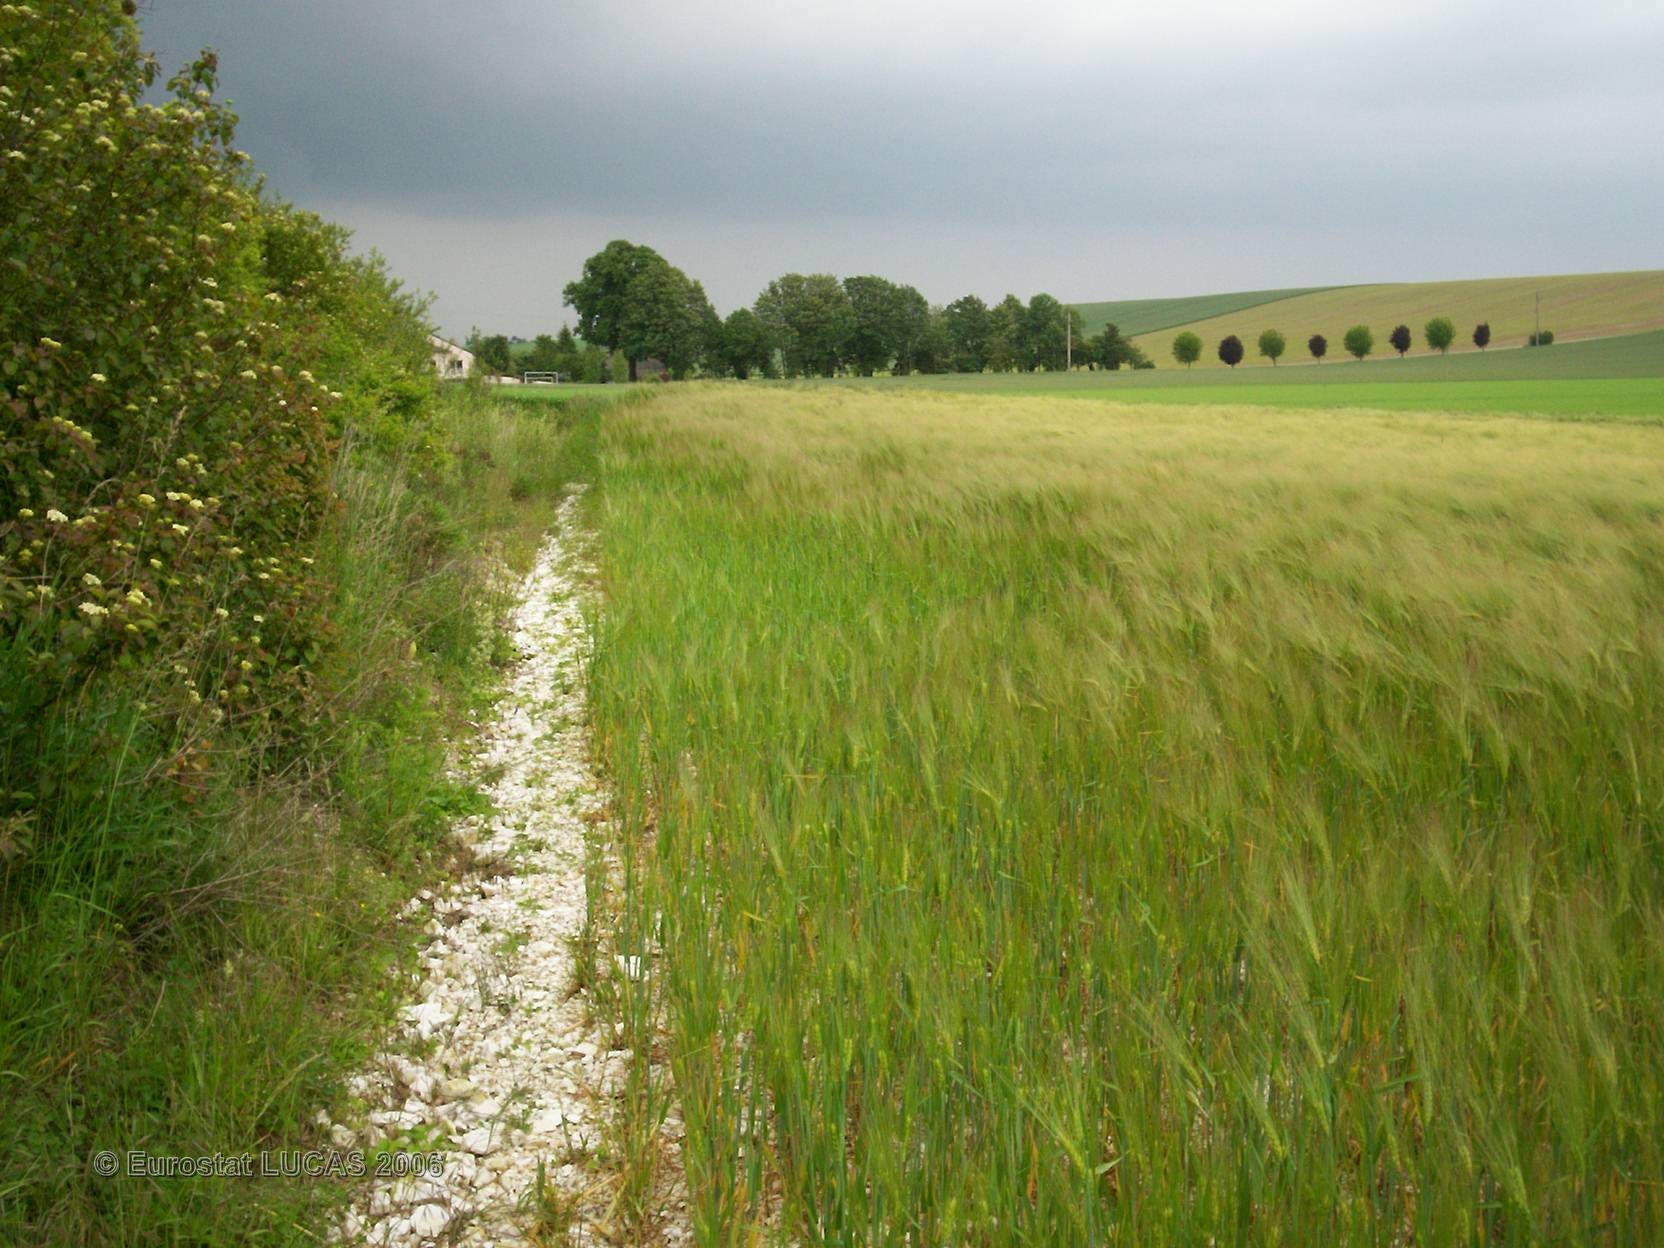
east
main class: Cropland
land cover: Barley
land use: Agriculture (excluding fallow land and kitchen gardens)
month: June
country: FR
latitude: 48.6785
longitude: 4.4420
